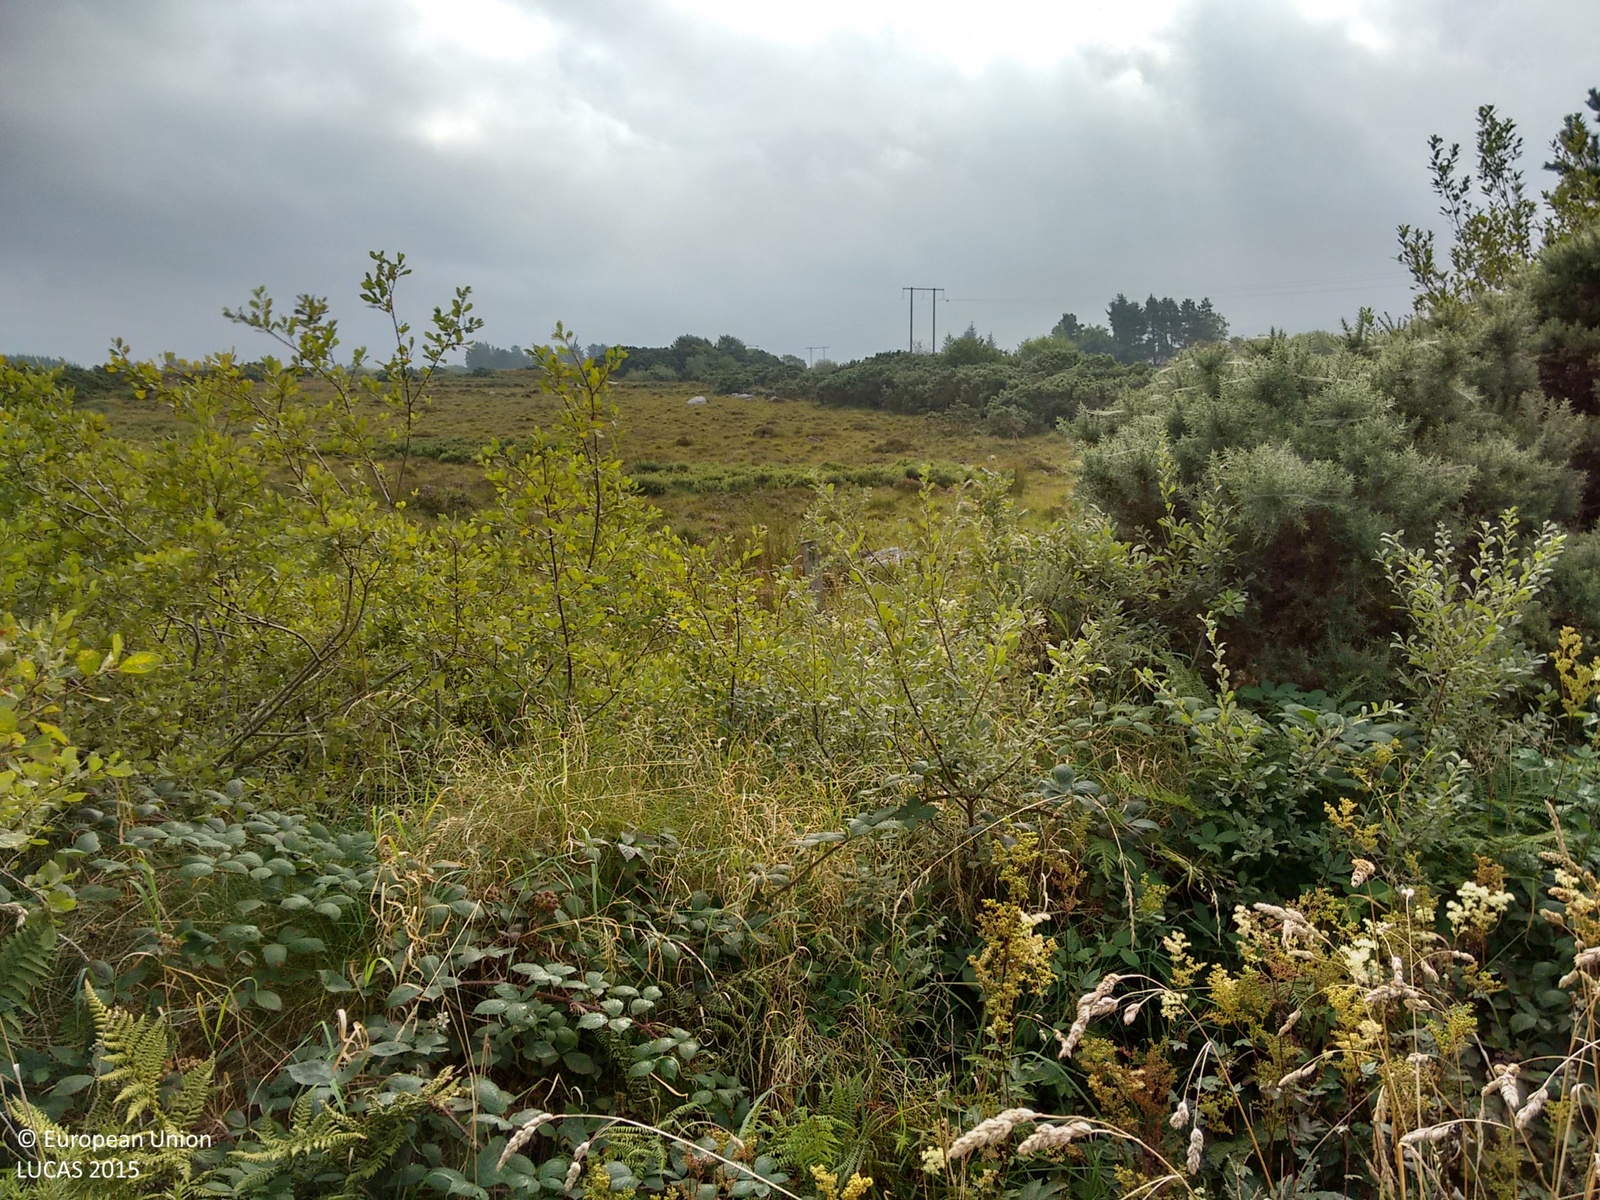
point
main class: Shrubland
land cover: Shrubland without tree cover
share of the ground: > 75 %
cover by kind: shrubs 80 %, herbaceous plants 20 %
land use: Semi-natural and natural areas not in use
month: September
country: IE
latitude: 54.1148
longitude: -9.0128
